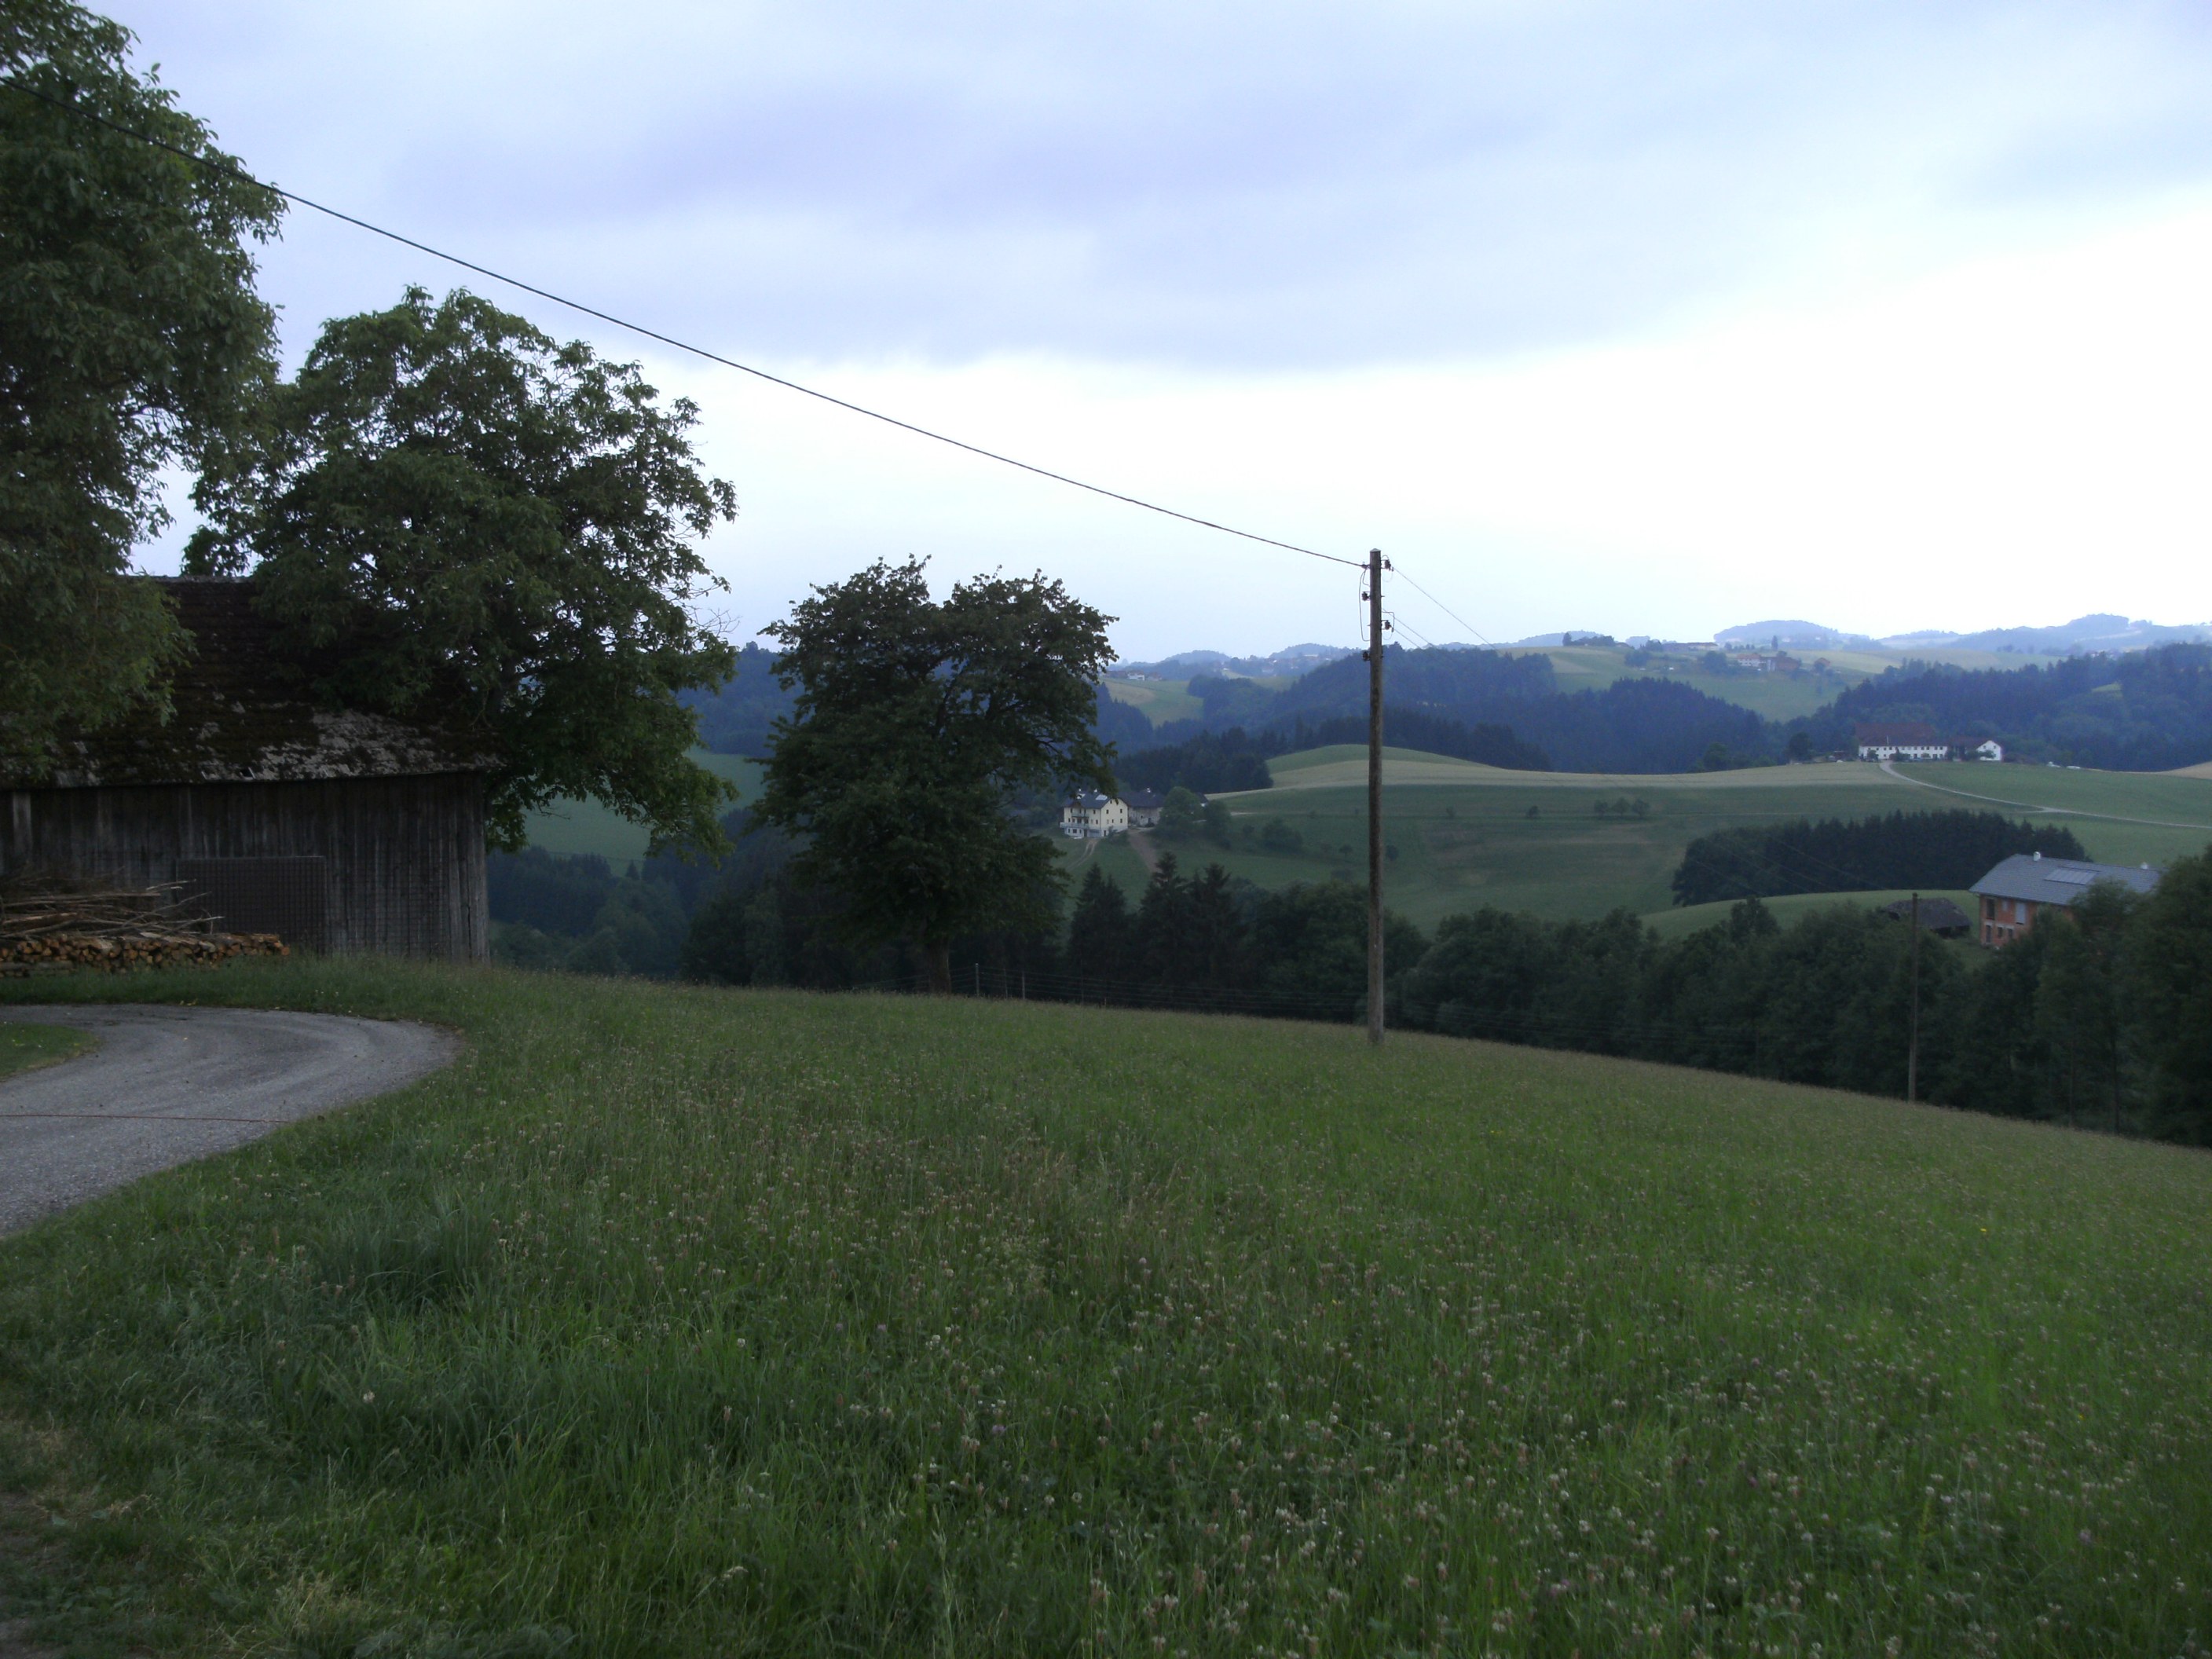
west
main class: Grassland
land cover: Grassland without tree/shrub cover
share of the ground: > 75 %
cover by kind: herbaceous plants 100 %
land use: Agriculture (excluding fallow land and kitchen gardens)
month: June
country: AT
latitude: 48.3988
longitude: 14.1196
